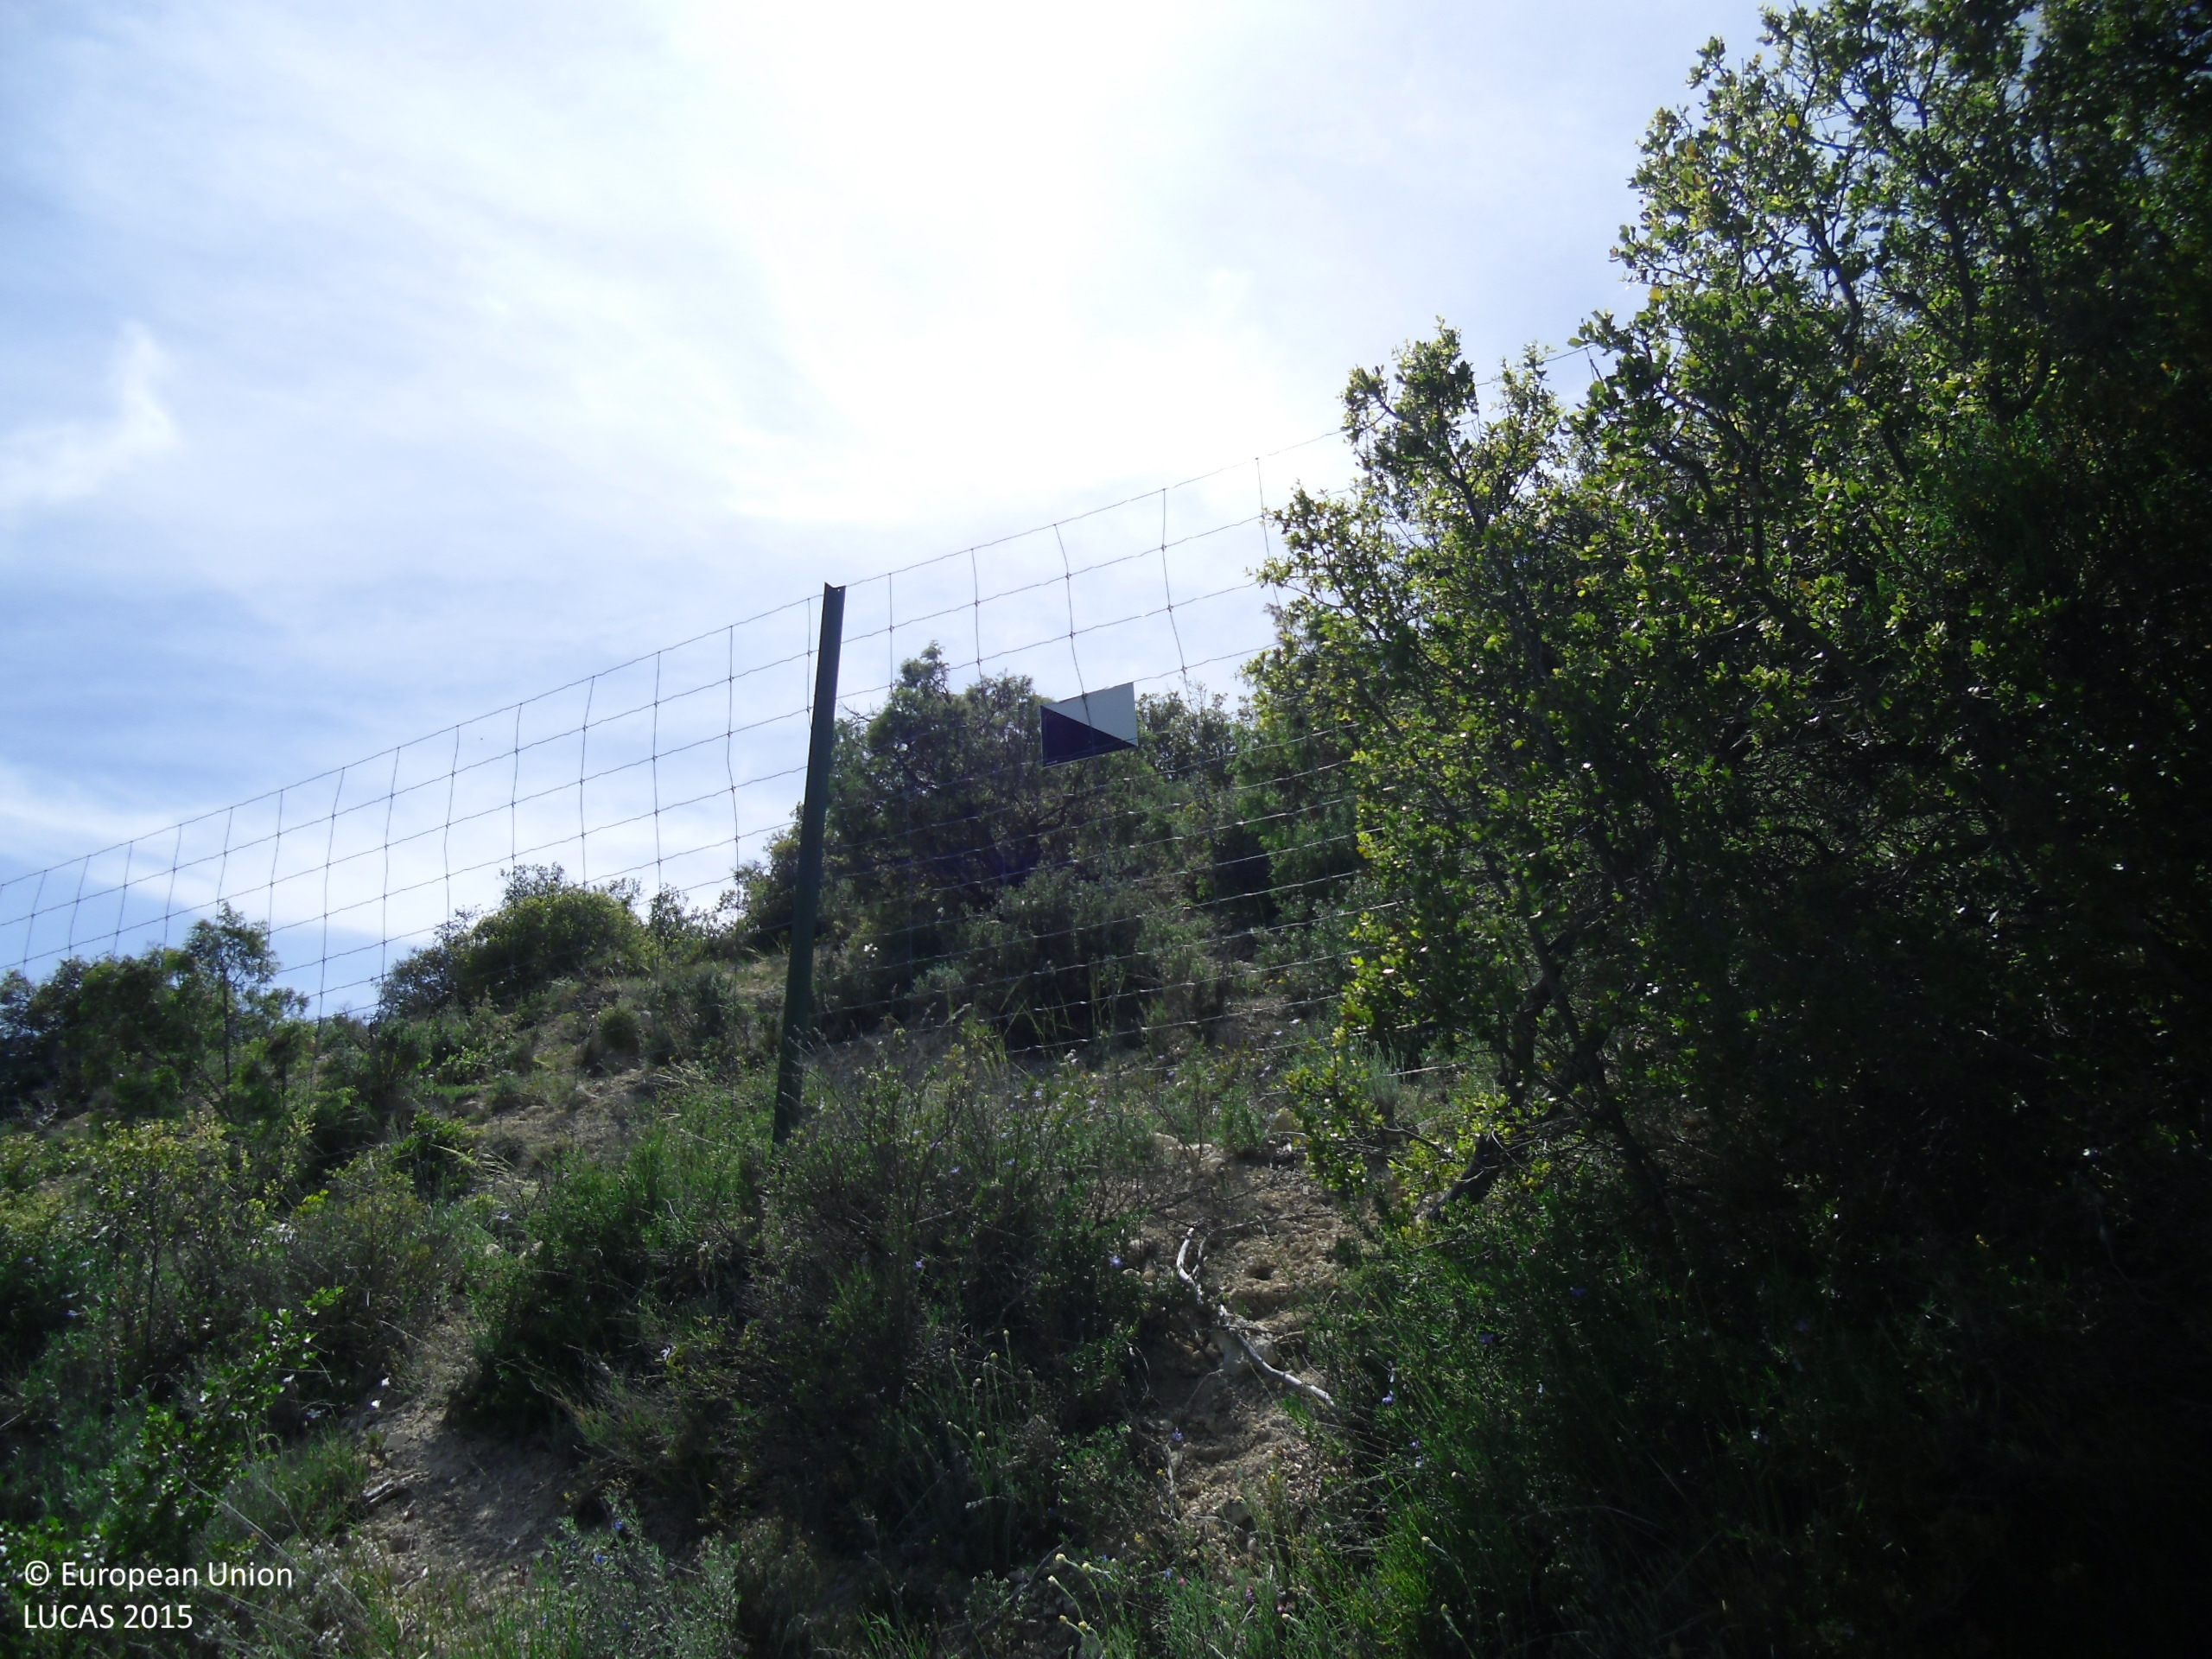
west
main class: Shrubland
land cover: Shrubland with sparse tree cover
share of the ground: 50 - 75 %
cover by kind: shrubs 65 %, herbaceous plants 30 %, broadleaved forest trees 5 %
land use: Semi-natural and natural areas not in use
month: May
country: ES
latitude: 40.4671
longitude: -2.9432
